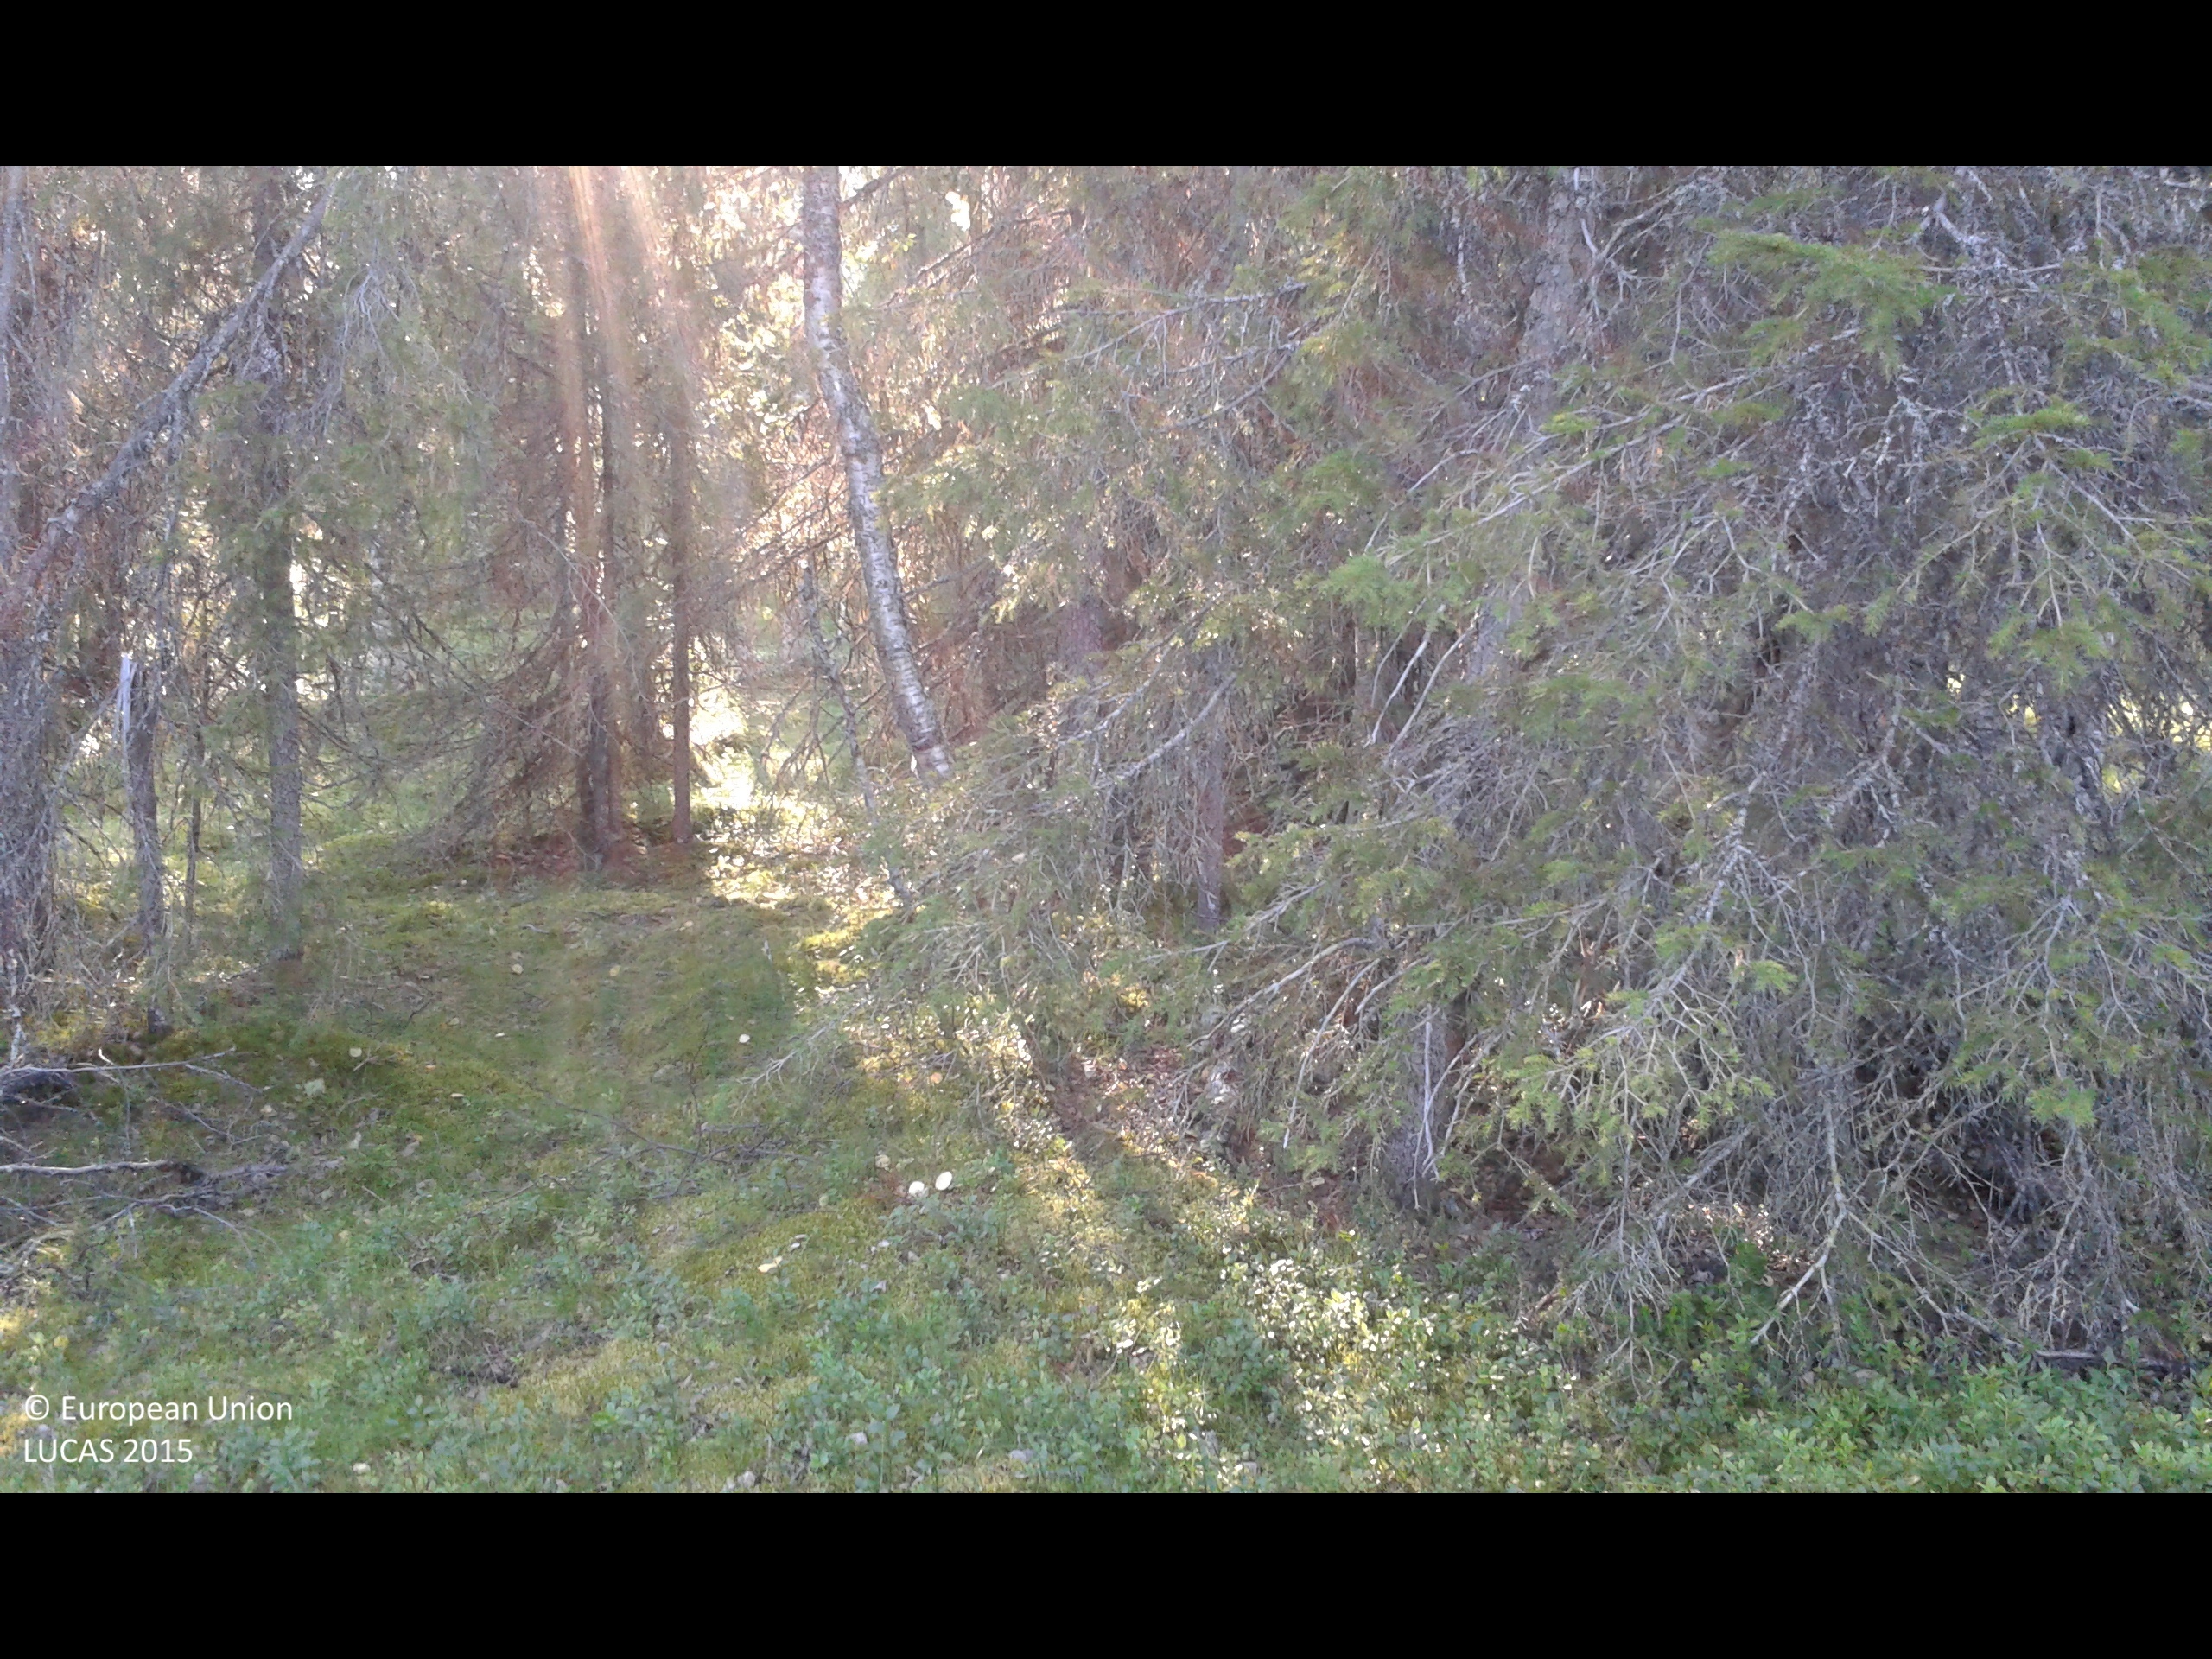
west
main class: Woodland
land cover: Spruce dominated mixed woodland
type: boreal forest
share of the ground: 25 - 50 %
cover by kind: shrubs 50 %, coniferous forest trees 25 %, lichens and mosses 15 %, broadleaved forest trees 10 %
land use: Forestry
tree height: > 5 m
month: August
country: SE
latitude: 67.3158
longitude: 21.1731
